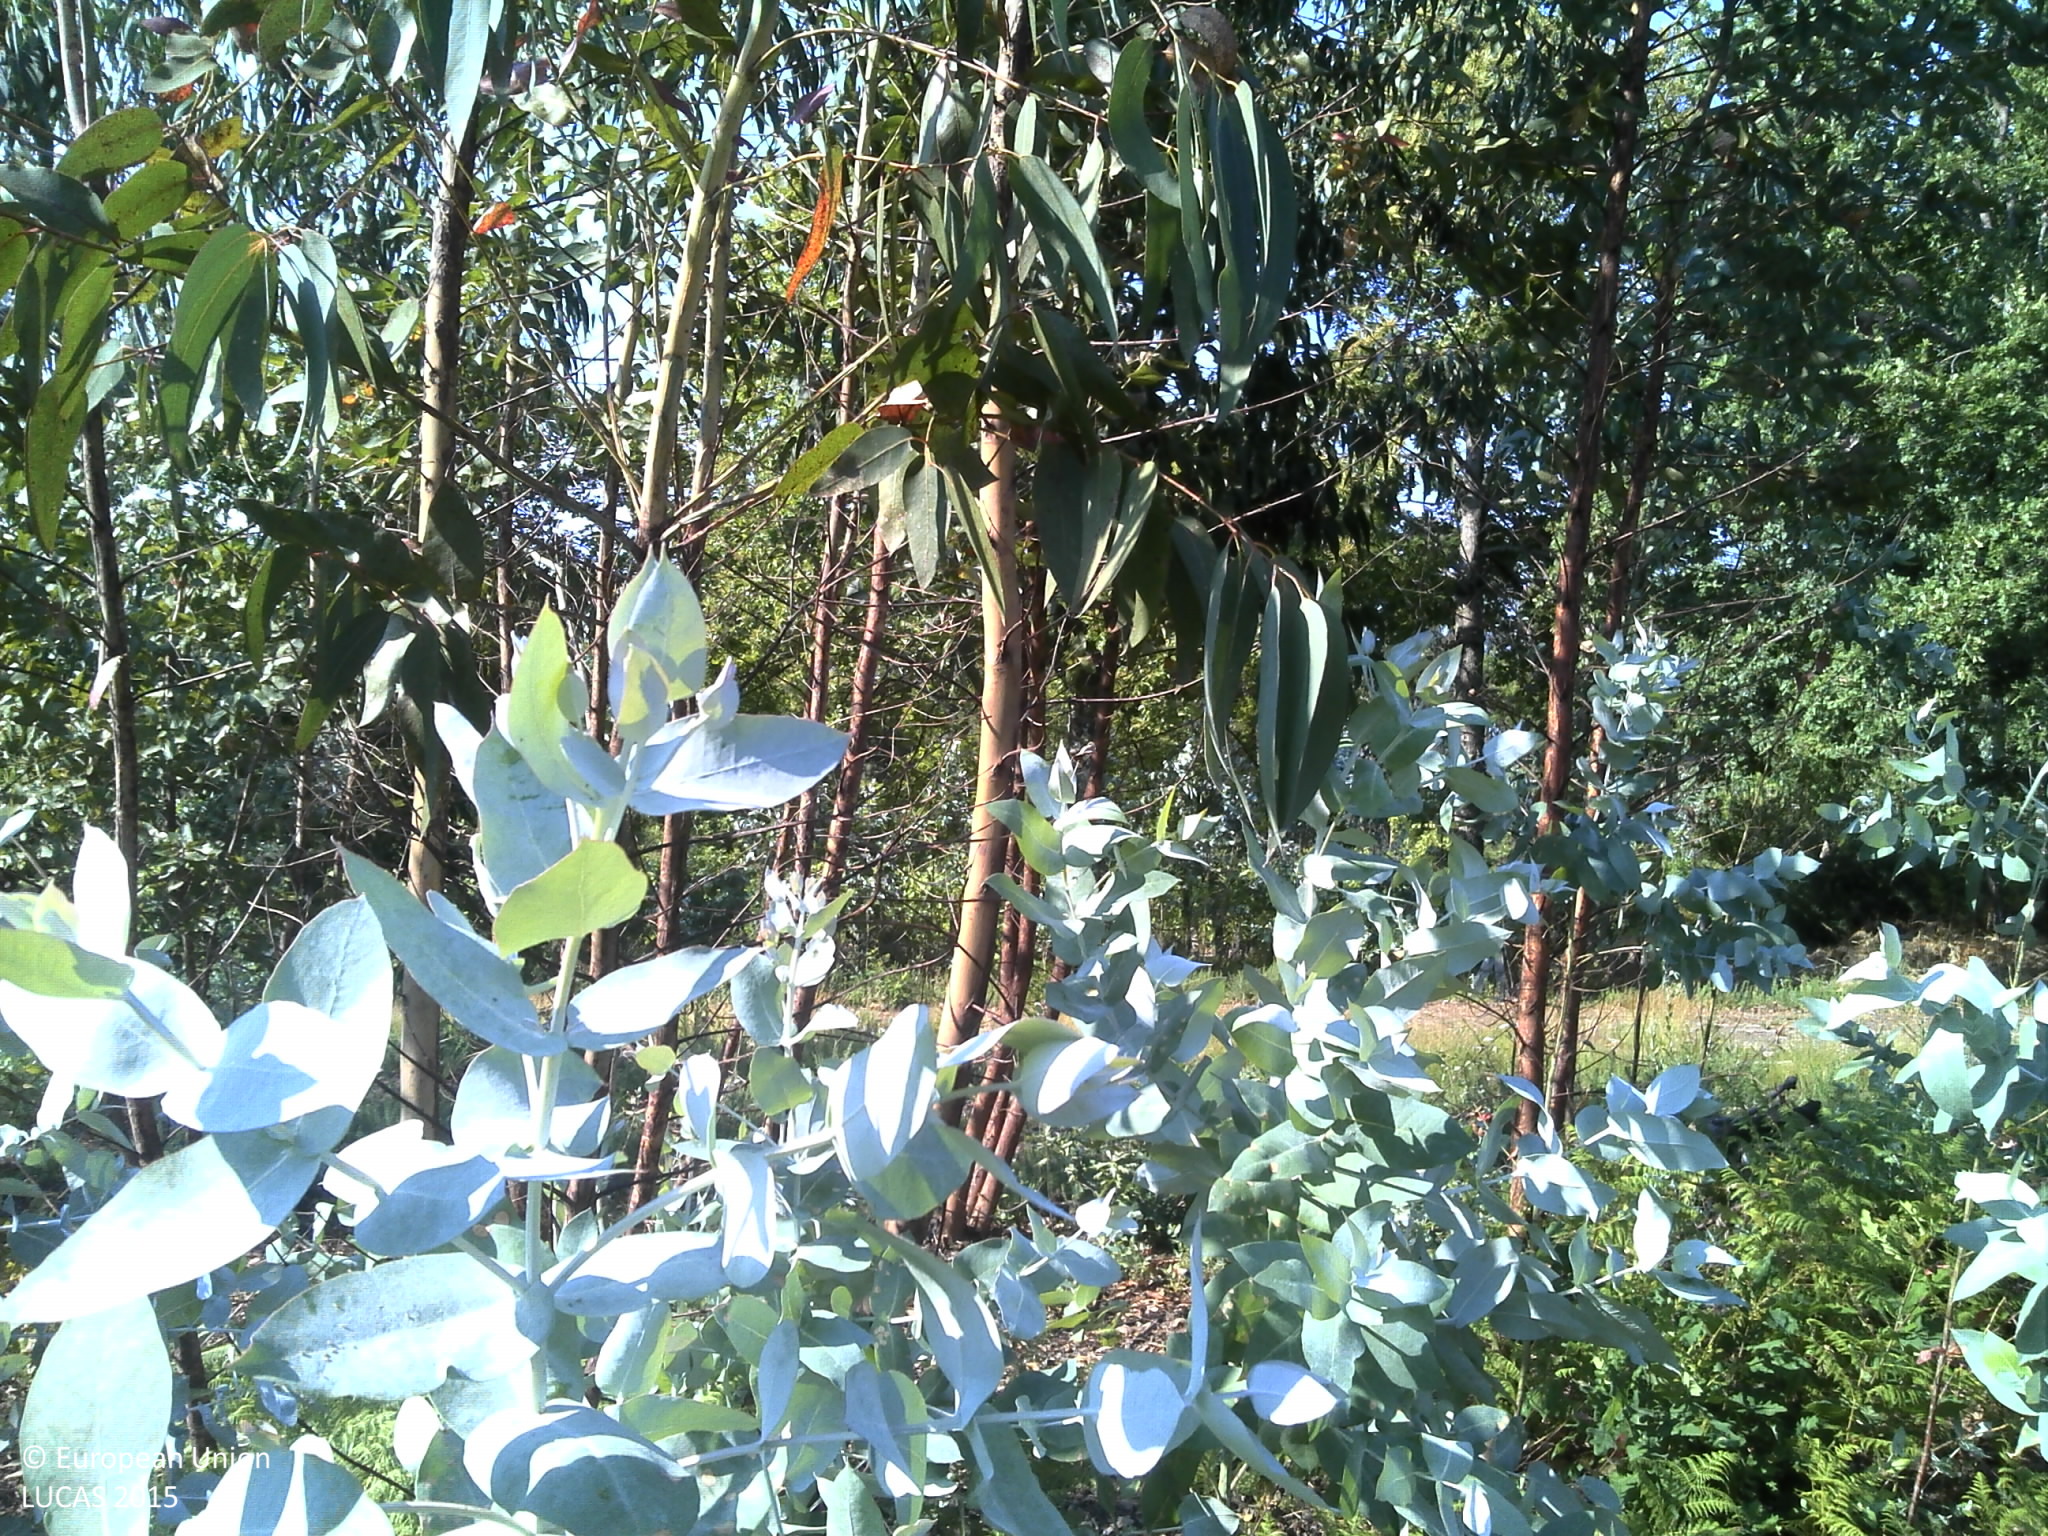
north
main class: Woodland
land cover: Broadleaved woodland
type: exotic forest
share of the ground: 50 - 75 %
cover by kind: broadleaved forest trees 60 %, shrubs 20 %, unconsolidated bare surface 20 %
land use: Forestry
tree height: < 5 m
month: June
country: PT
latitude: 40.6221
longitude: -8.0849
